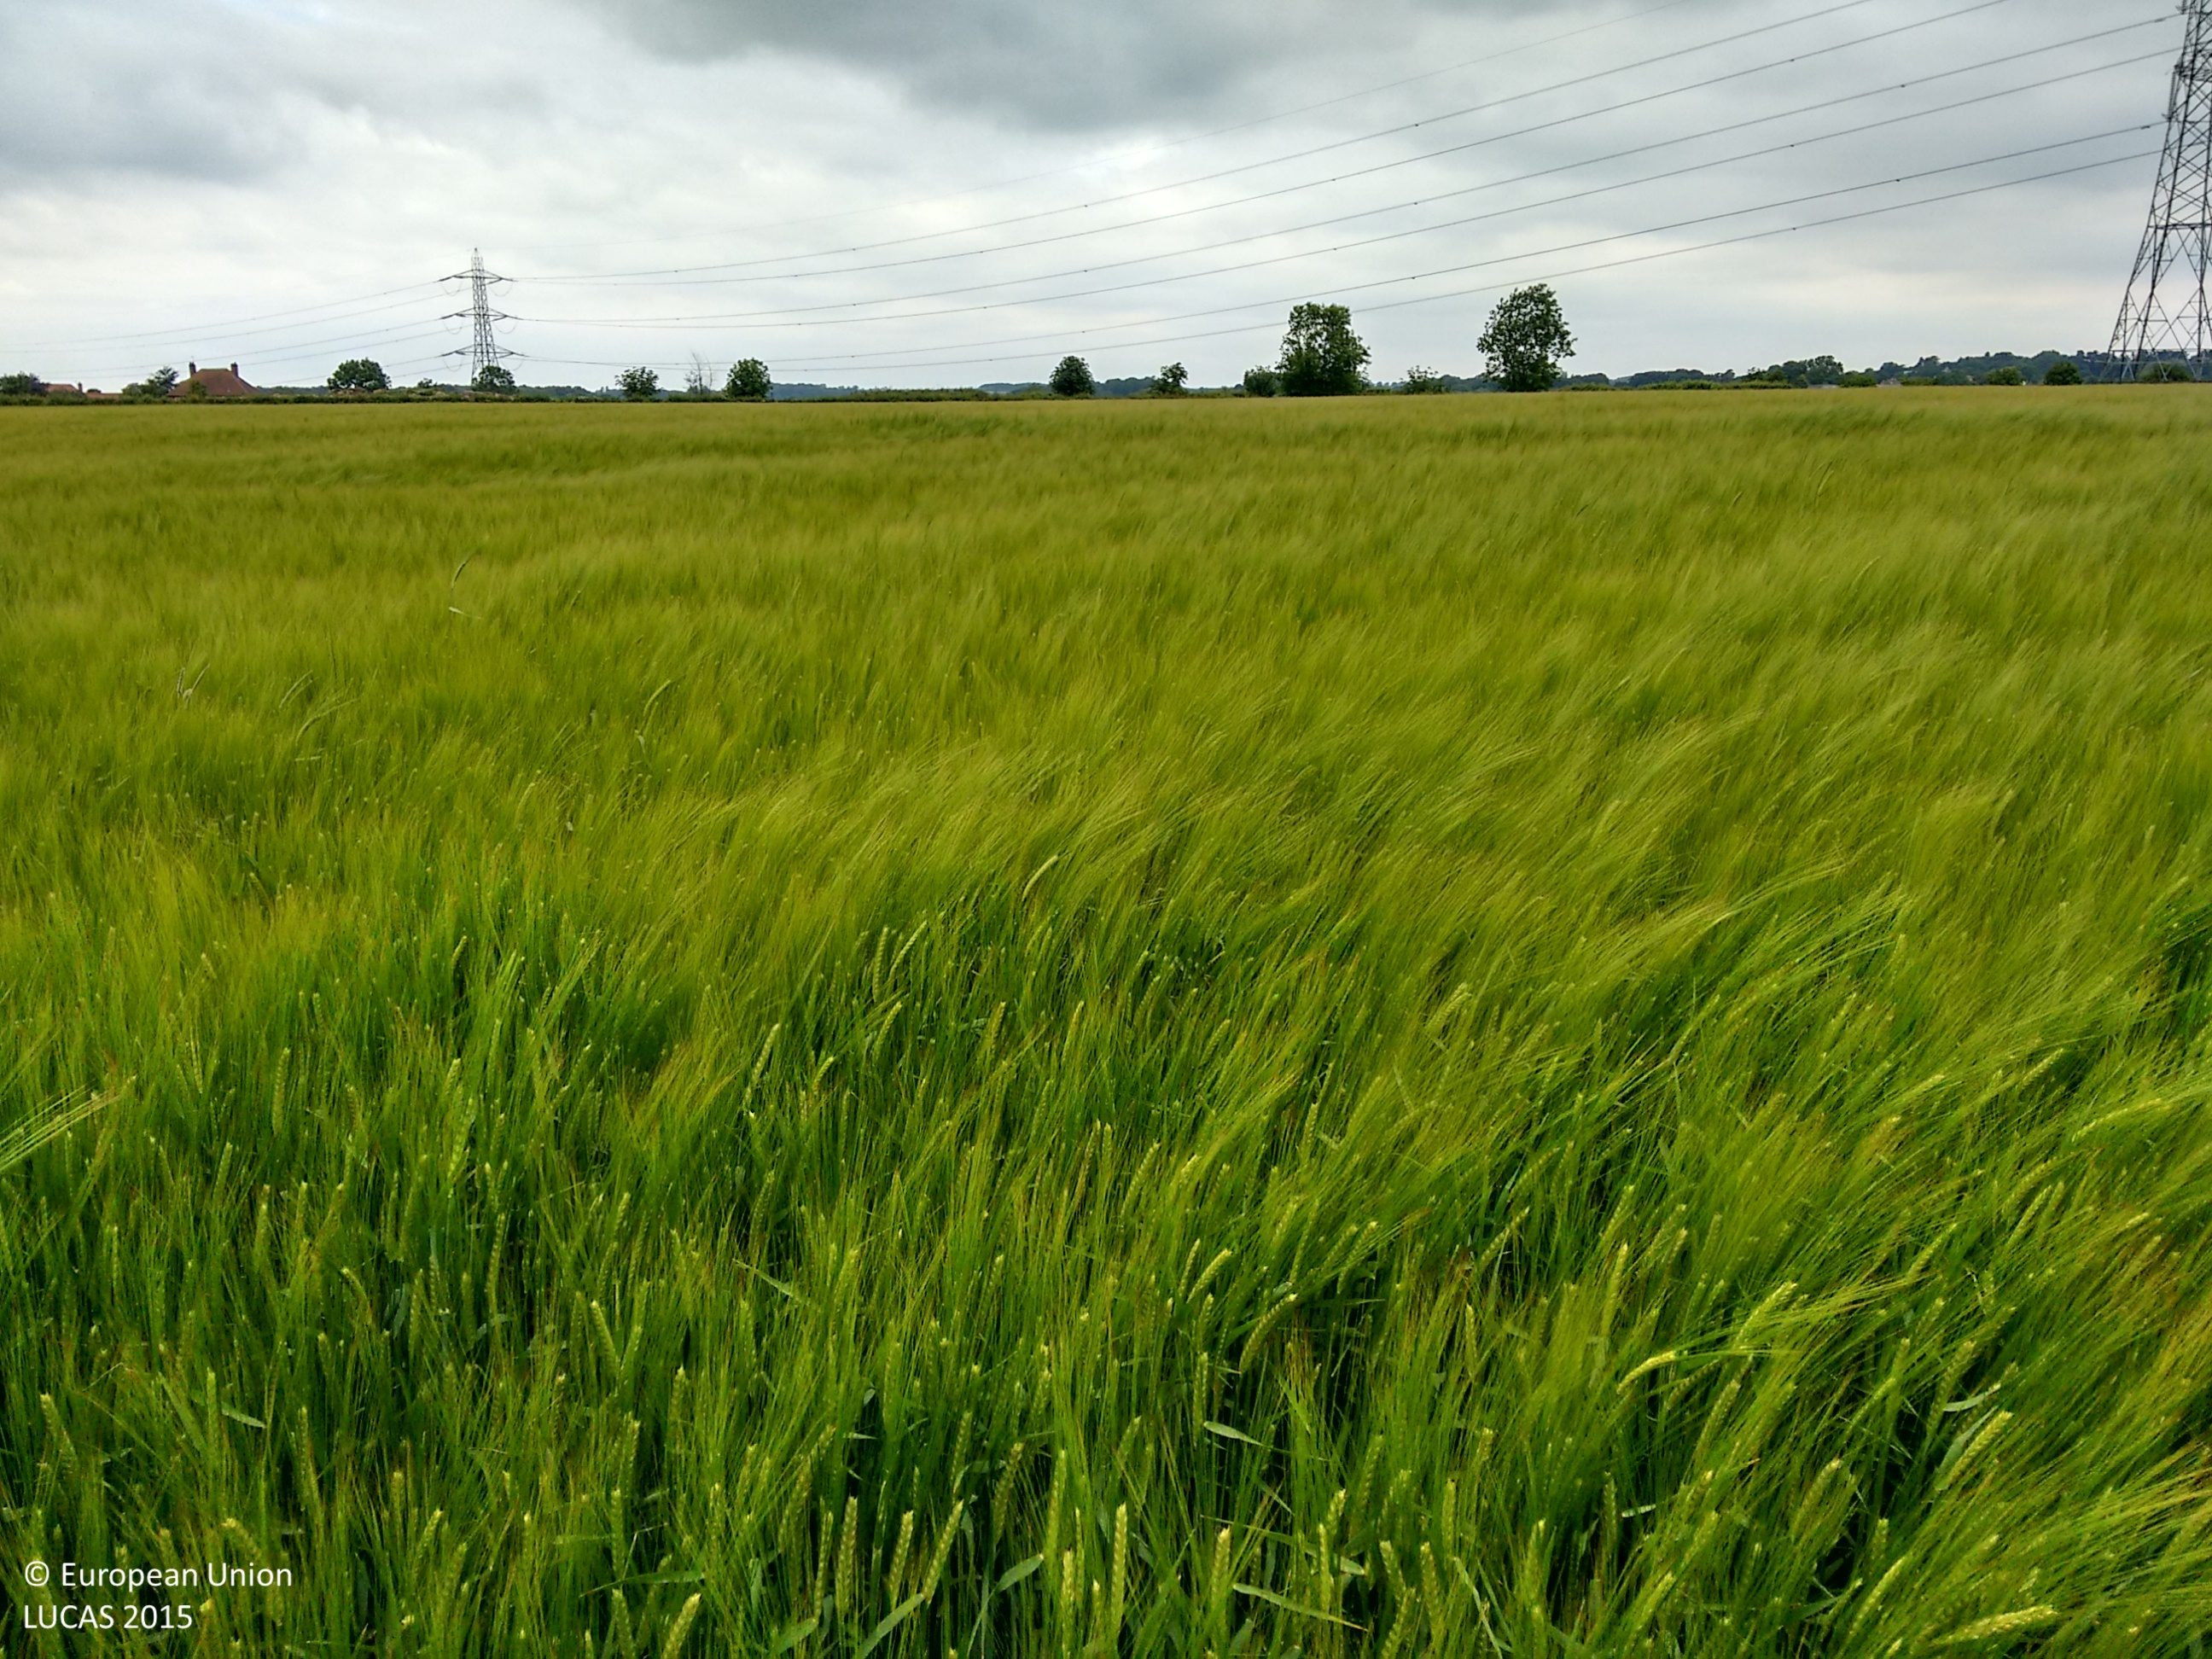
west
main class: Cropland
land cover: Barley
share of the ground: > 75 %
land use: Agriculture (excluding fallow land and kitchen gardens)
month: June
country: GB
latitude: 53.0013
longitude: -0.8753
